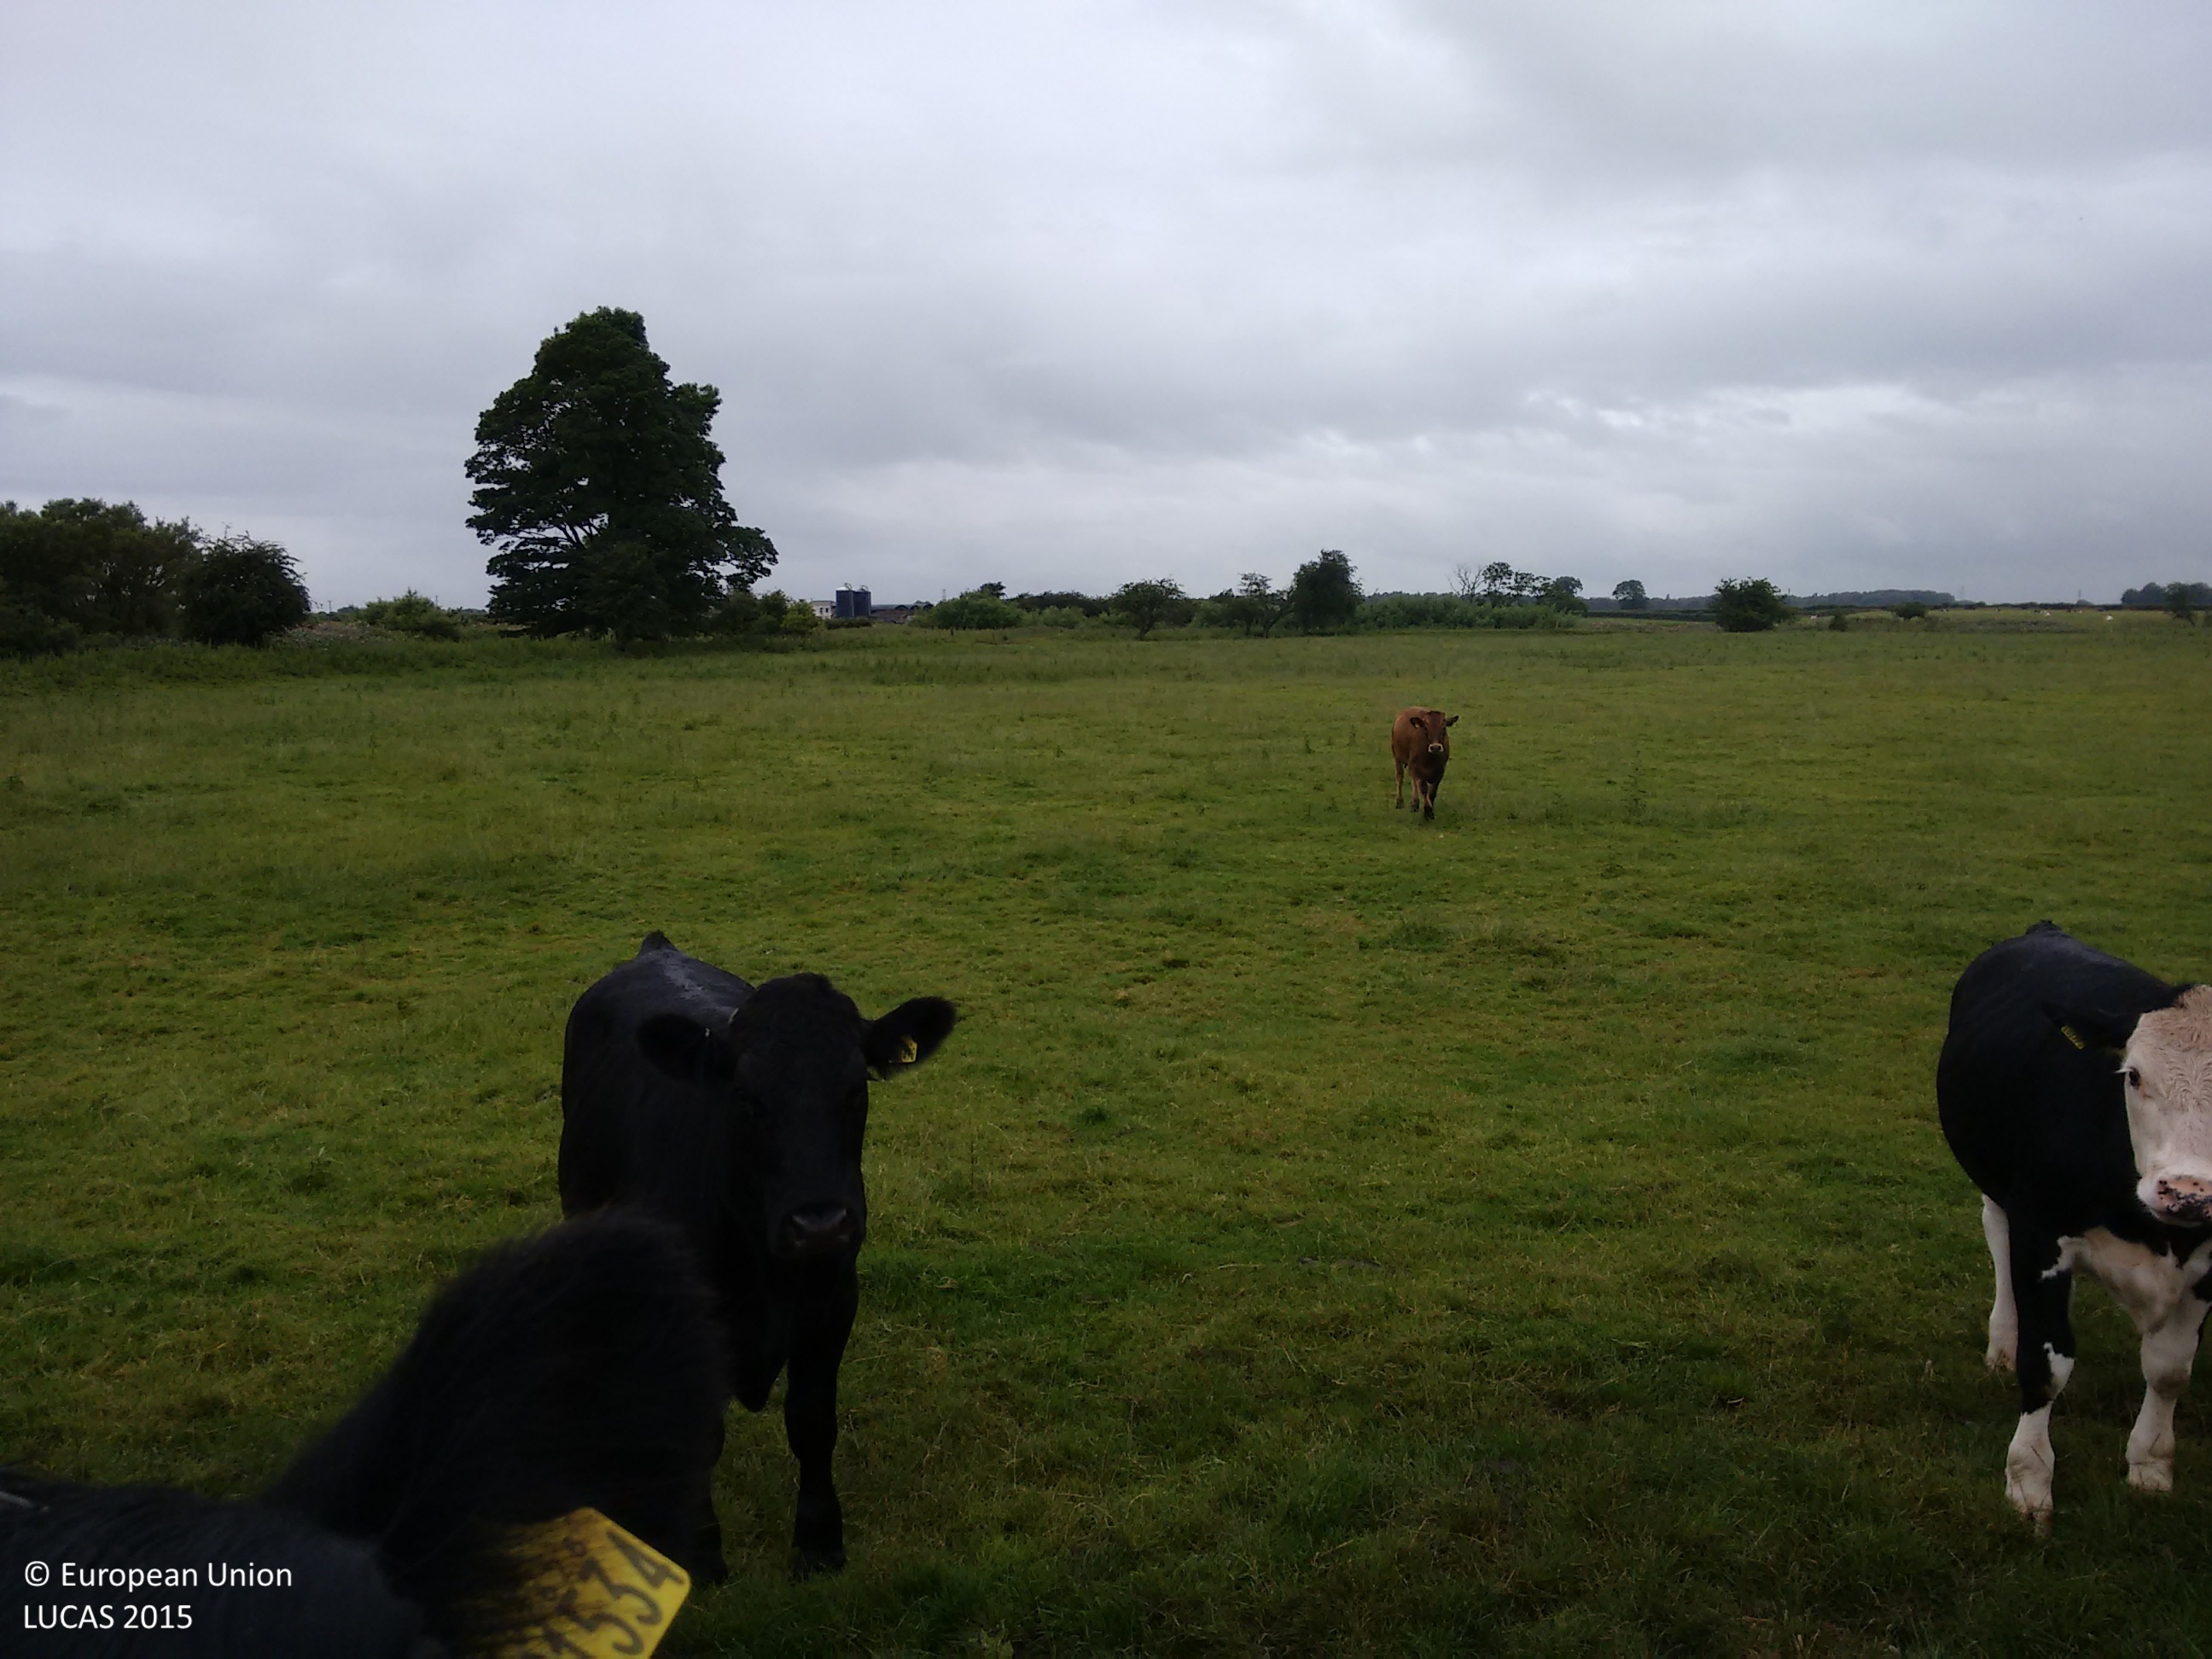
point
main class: Grassland
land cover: Grassland without tree/shrub cover
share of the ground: > 75 %
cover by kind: herbaceous plants 100 %
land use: Agriculture (excluding fallow land and kitchen gardens)
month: July
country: GB
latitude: 54.9830
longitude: -2.9305
